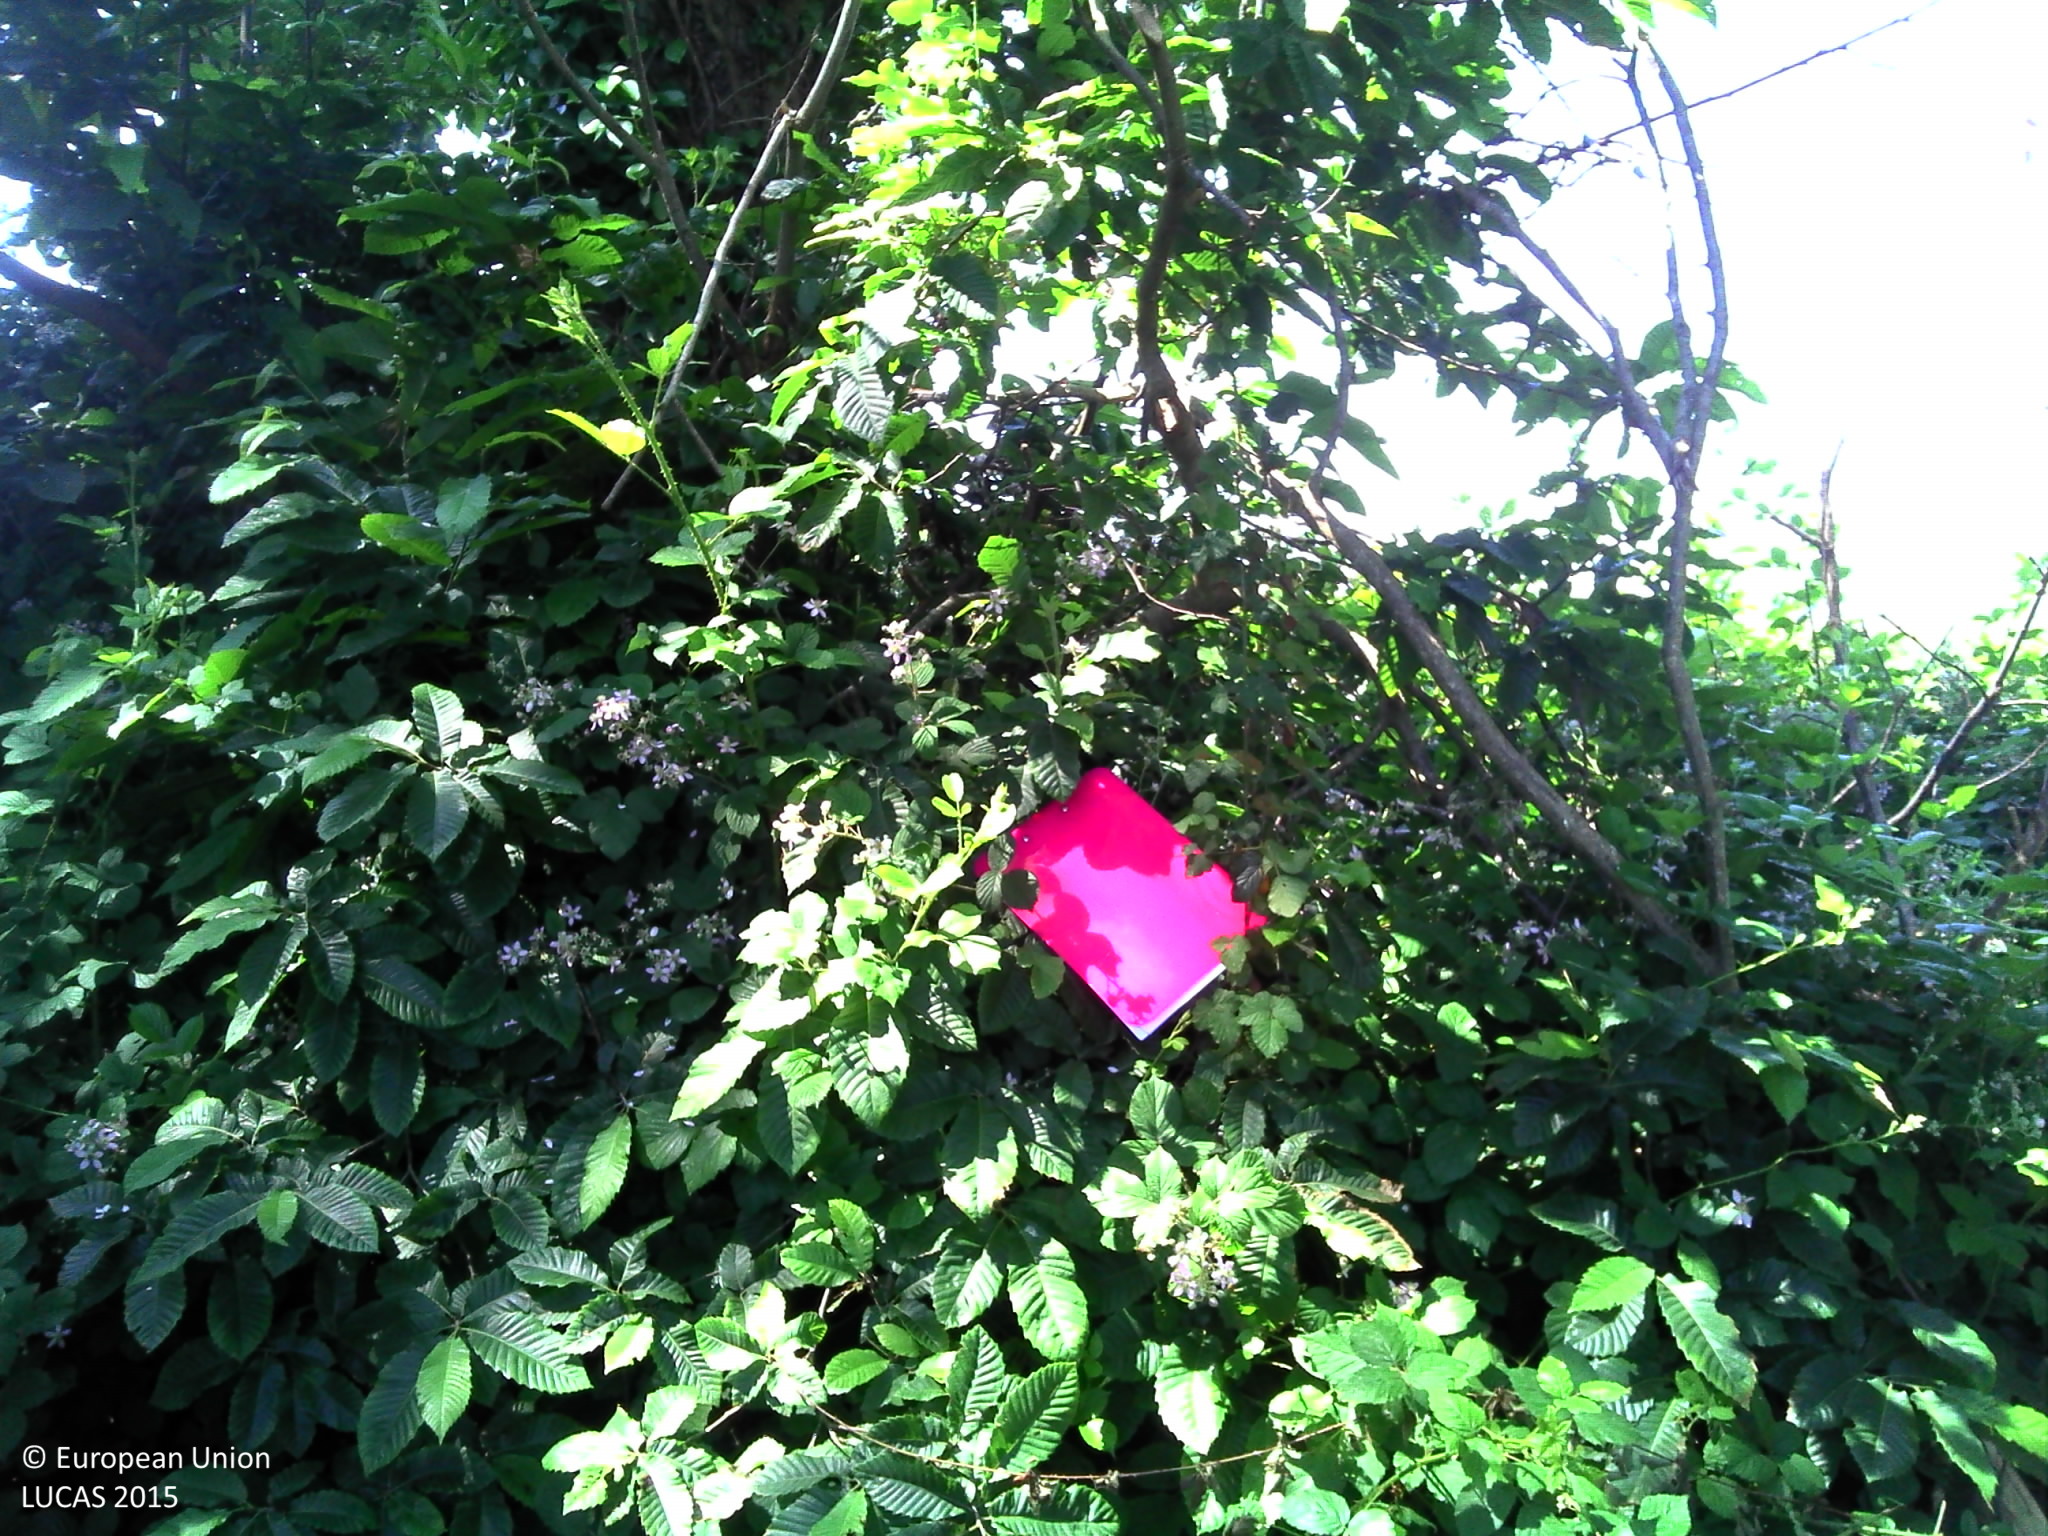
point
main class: Woodland
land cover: Broadleaved woodland
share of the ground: > 75 %
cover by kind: broadleaved forest trees 75 %, herbaceous plants 20 %, unconsolidated bare surface 5 %
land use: Forestry
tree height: > 5 m
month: June
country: FR
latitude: 48.3328
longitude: -1.7998
